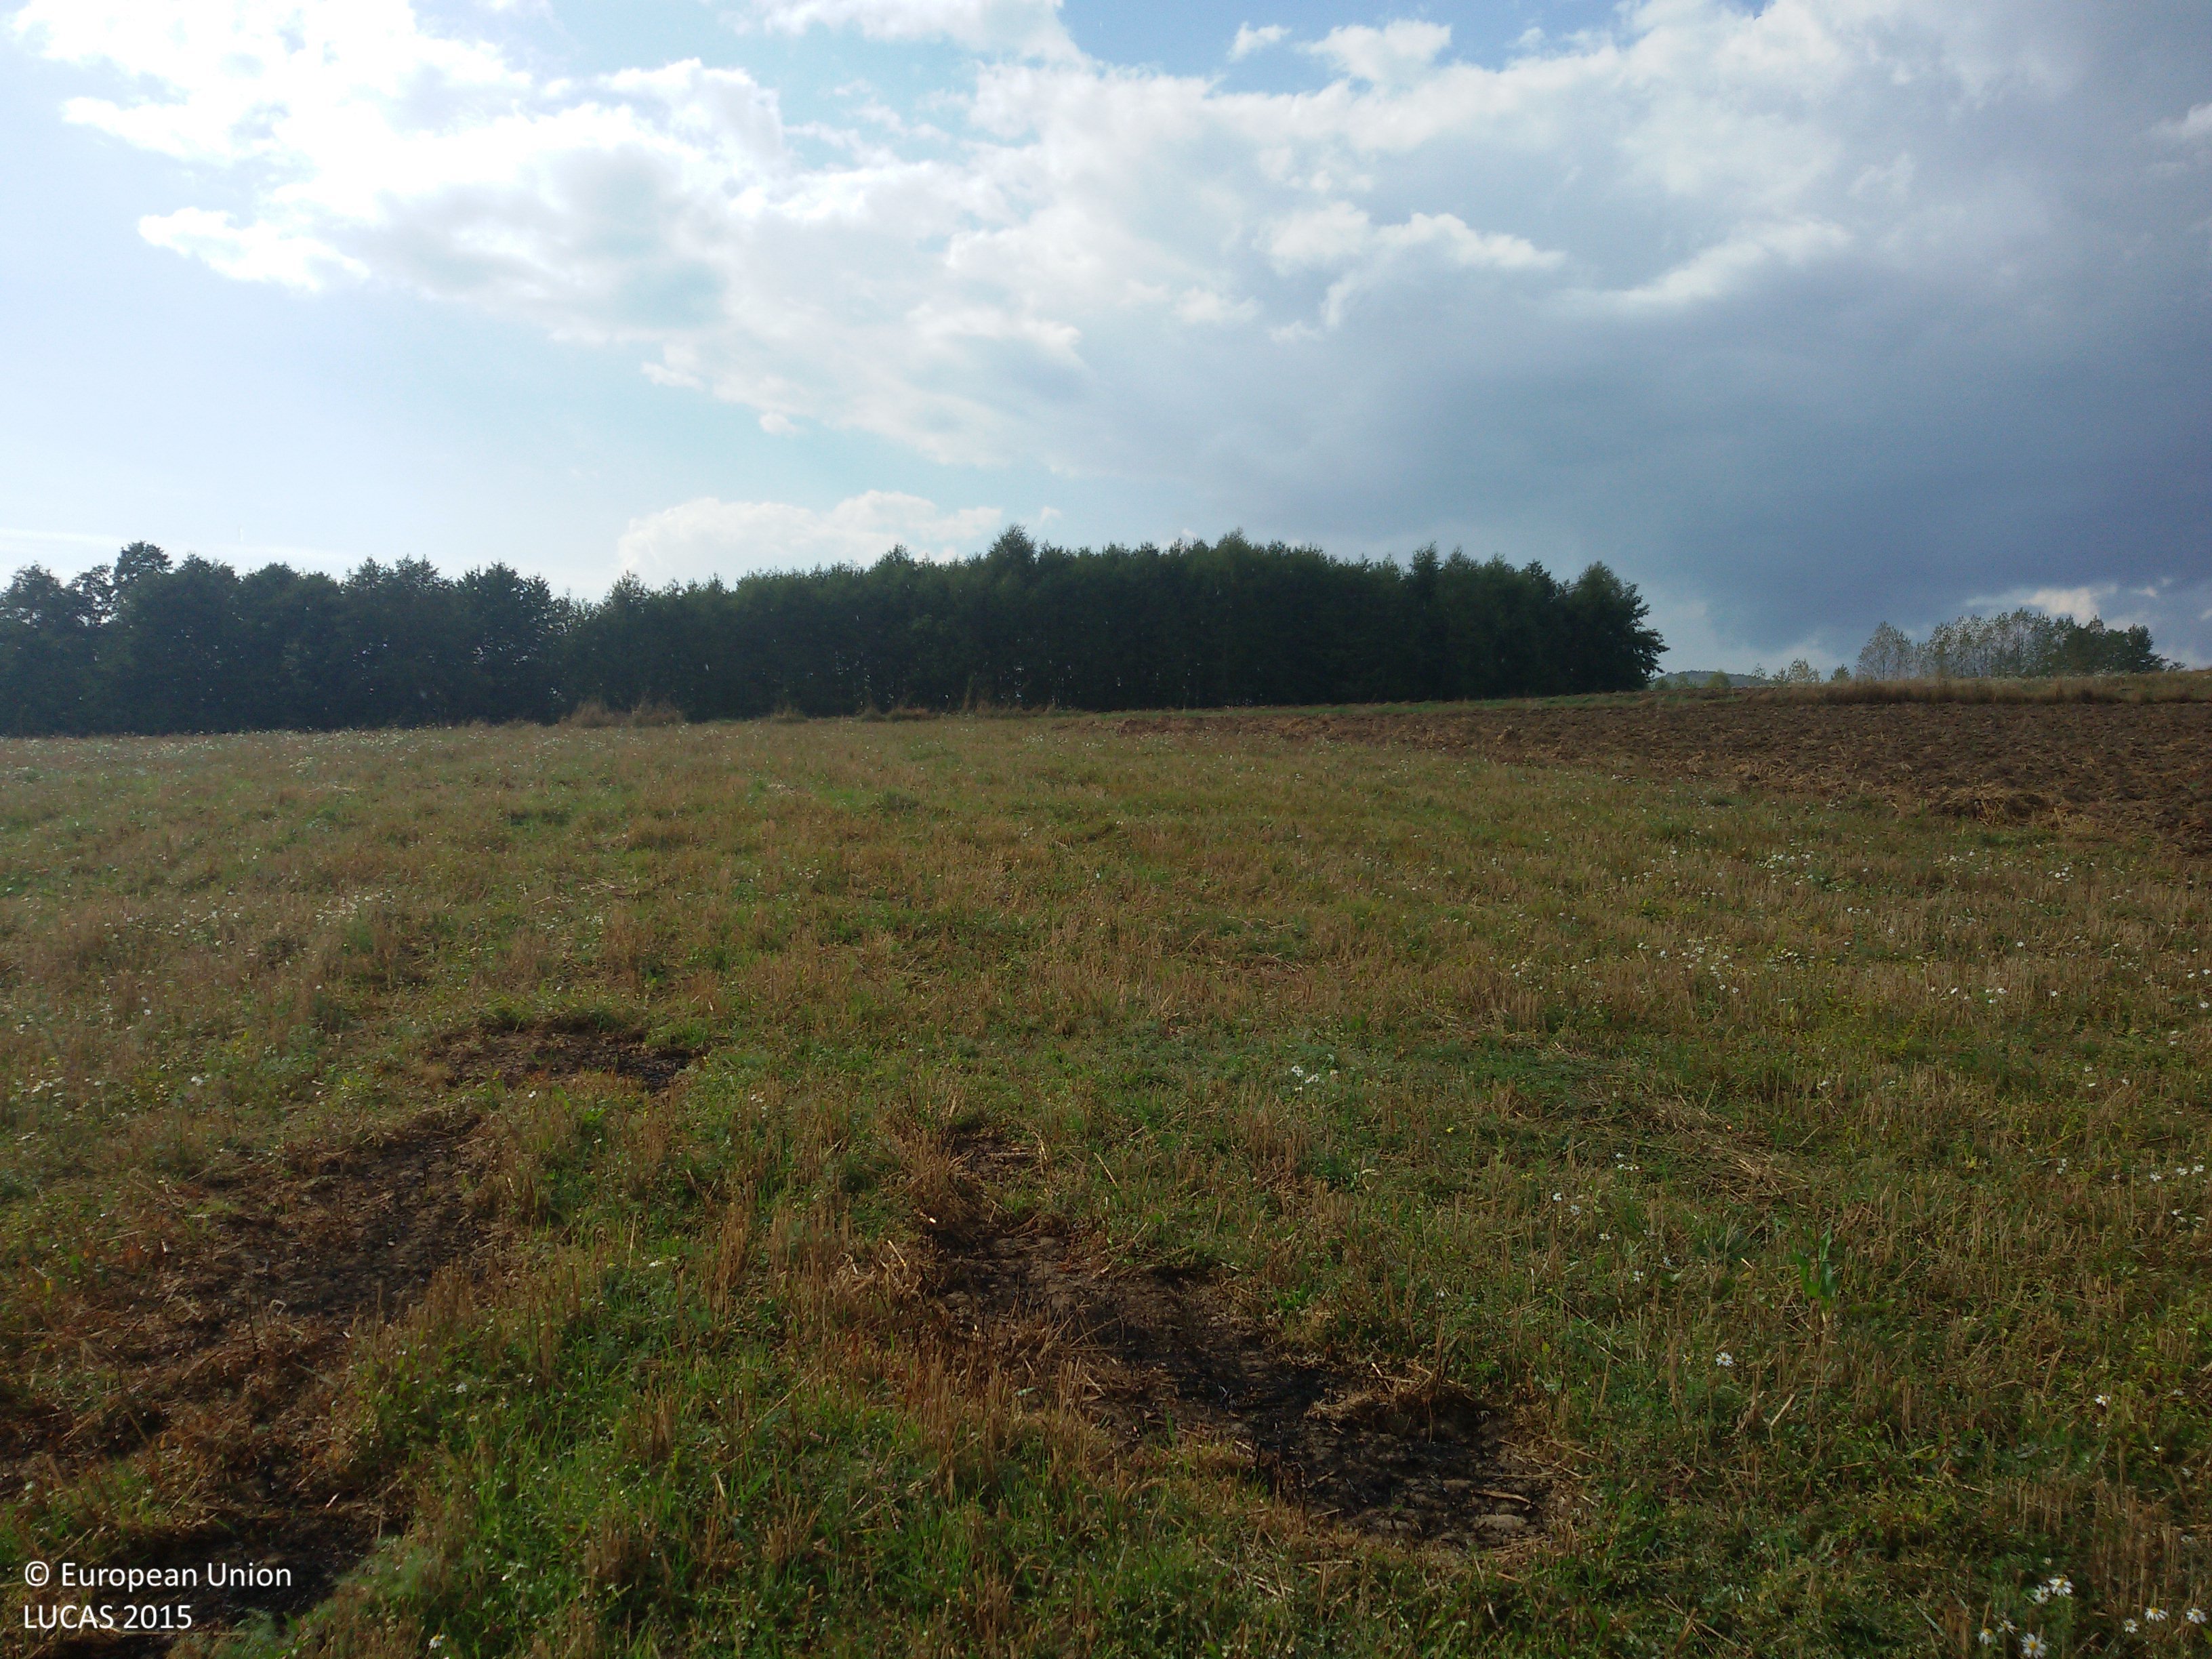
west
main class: Cropland
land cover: Rye
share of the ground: 25 - 50 %
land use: Agriculture (excluding fallow land and kitchen gardens)
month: September
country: PL
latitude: 49.9153
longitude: 21.2577
